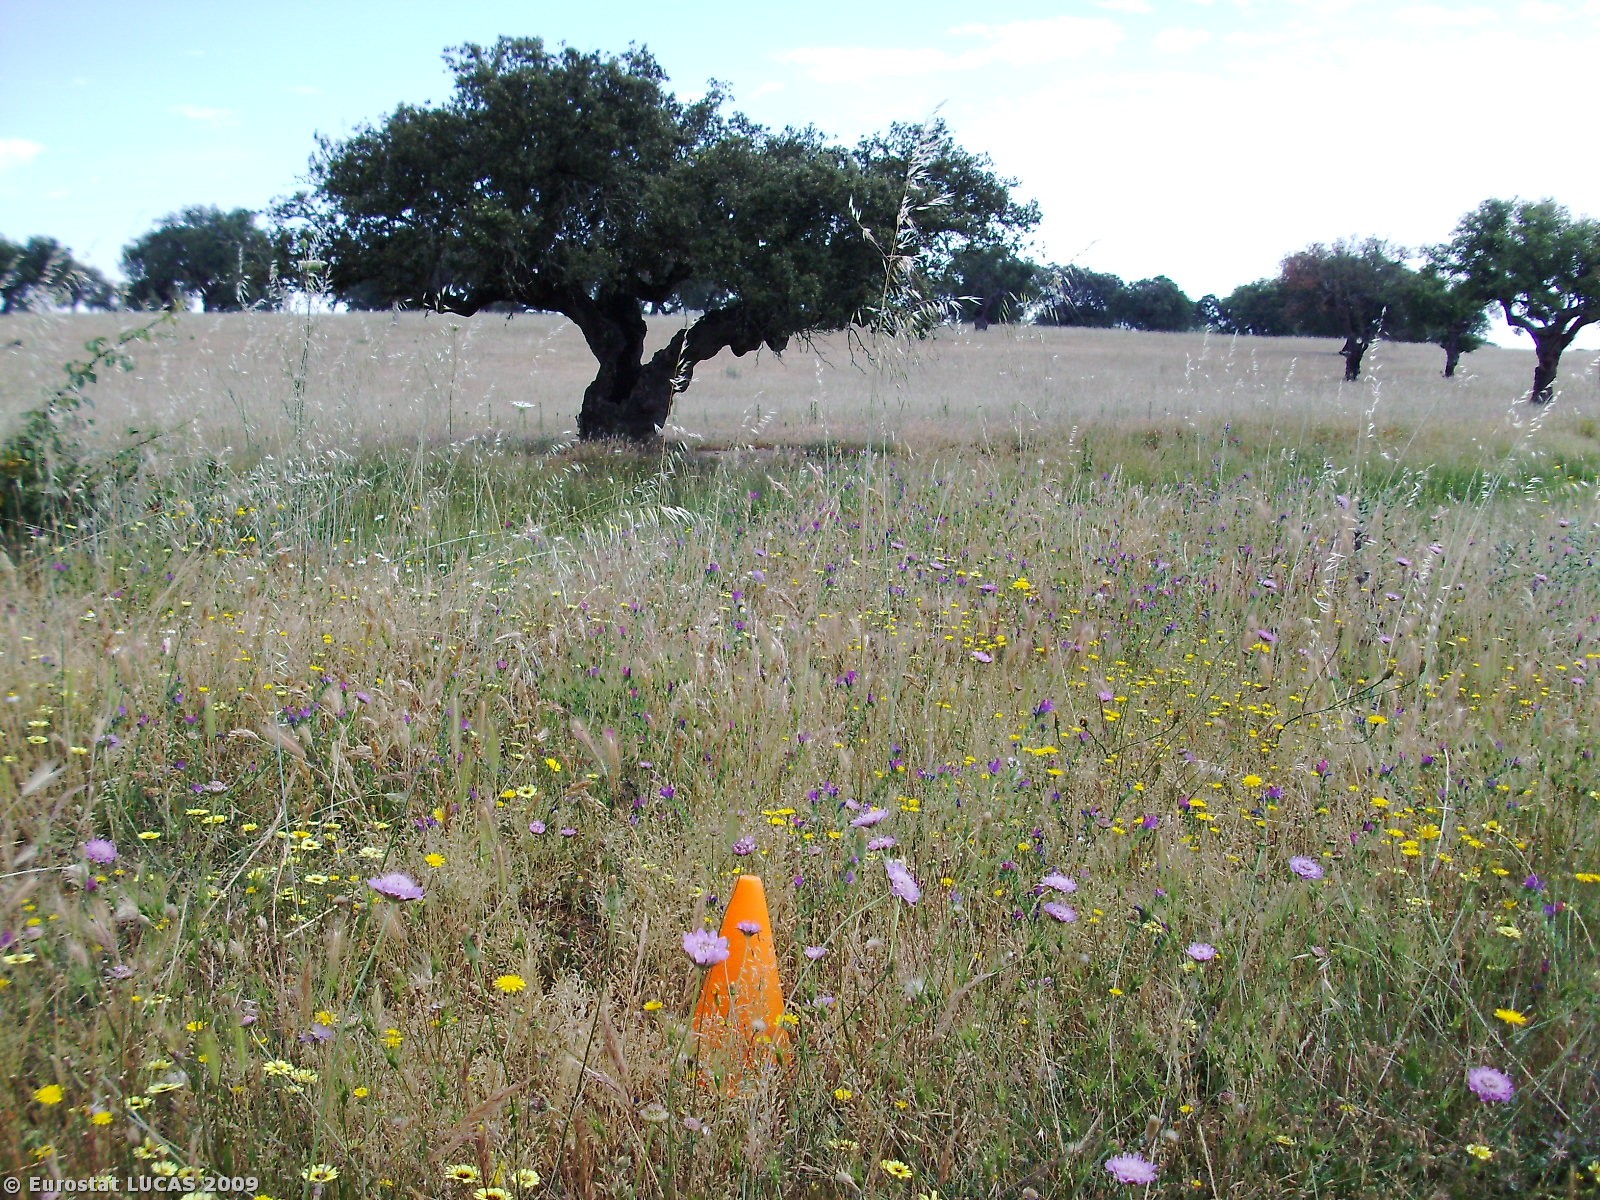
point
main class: Grassland
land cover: Grassland with sparse tree/shrub cover
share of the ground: > 75 %
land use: Agriculture (excluding fallow land and kitchen gardens)
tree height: > 5 m
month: June
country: PT
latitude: 39.1899
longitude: -7.4411
